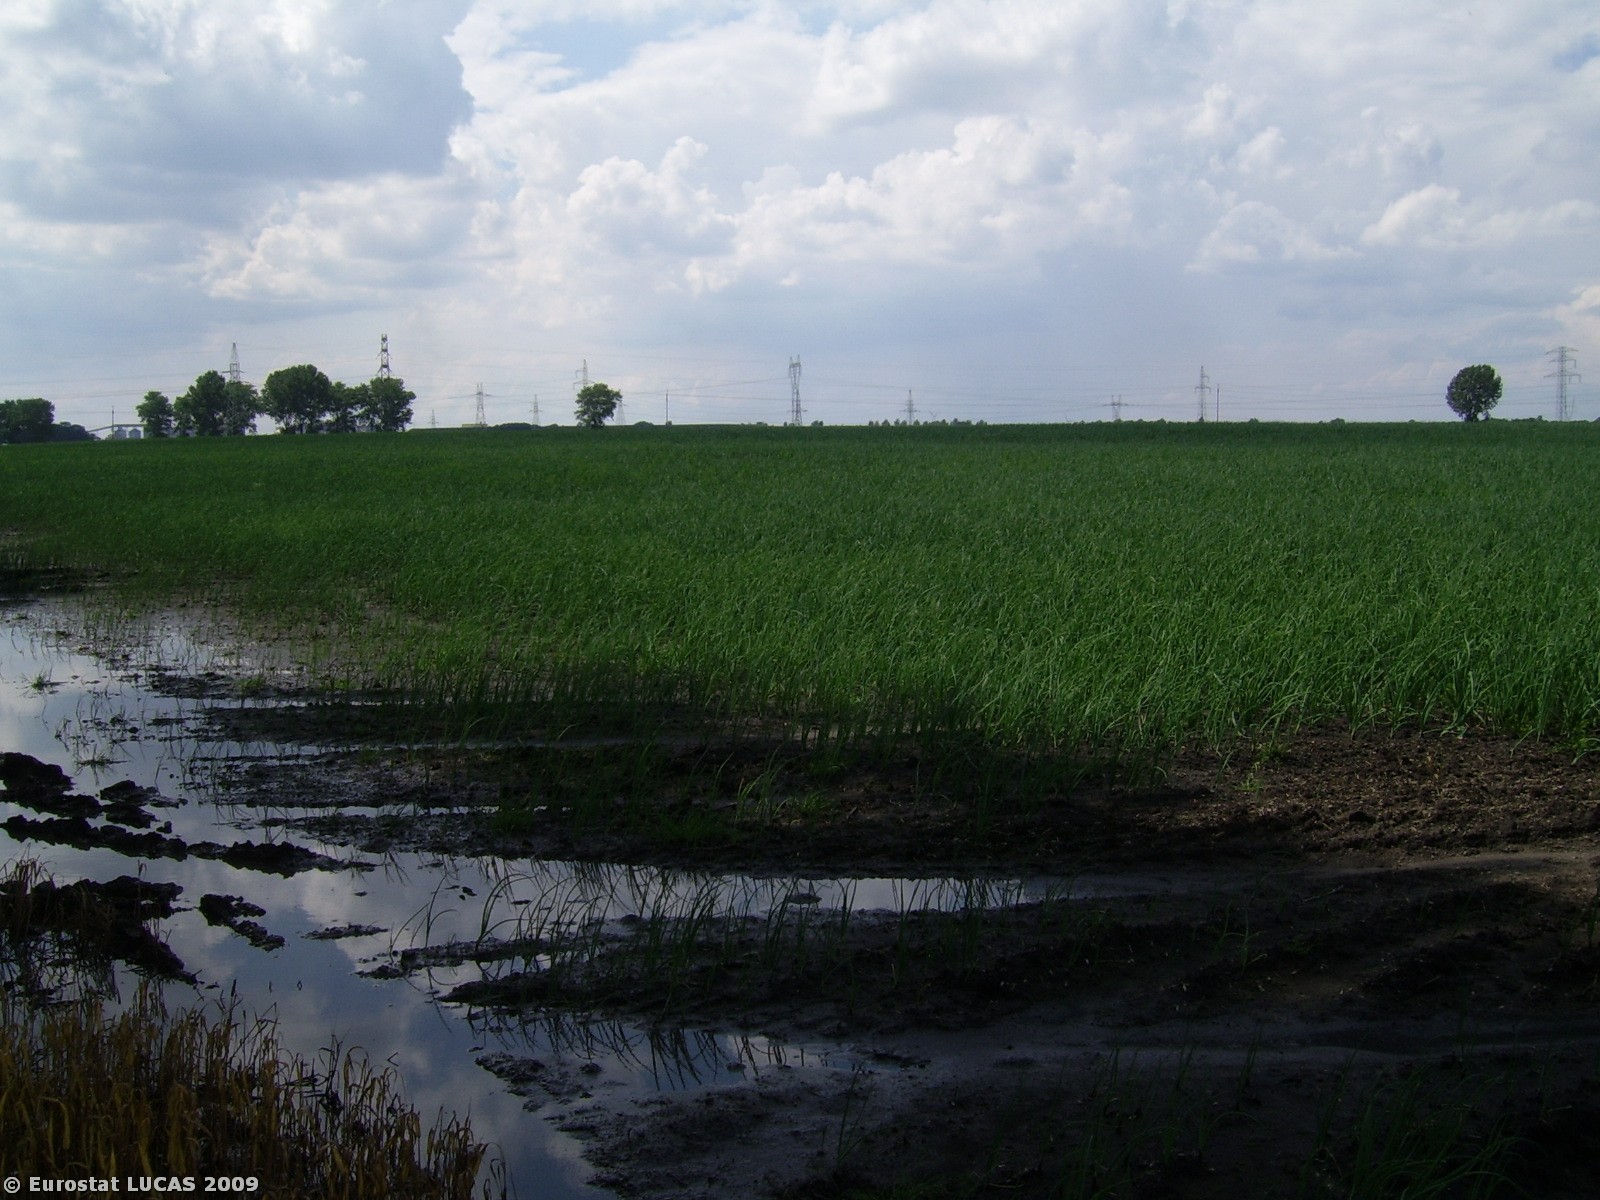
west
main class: Cropland
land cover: Other fresh vegetables
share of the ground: > 75 %
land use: Agriculture (excluding fallow land and kitchen gardens)
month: July
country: PL
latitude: 52.7654
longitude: 18.1527
